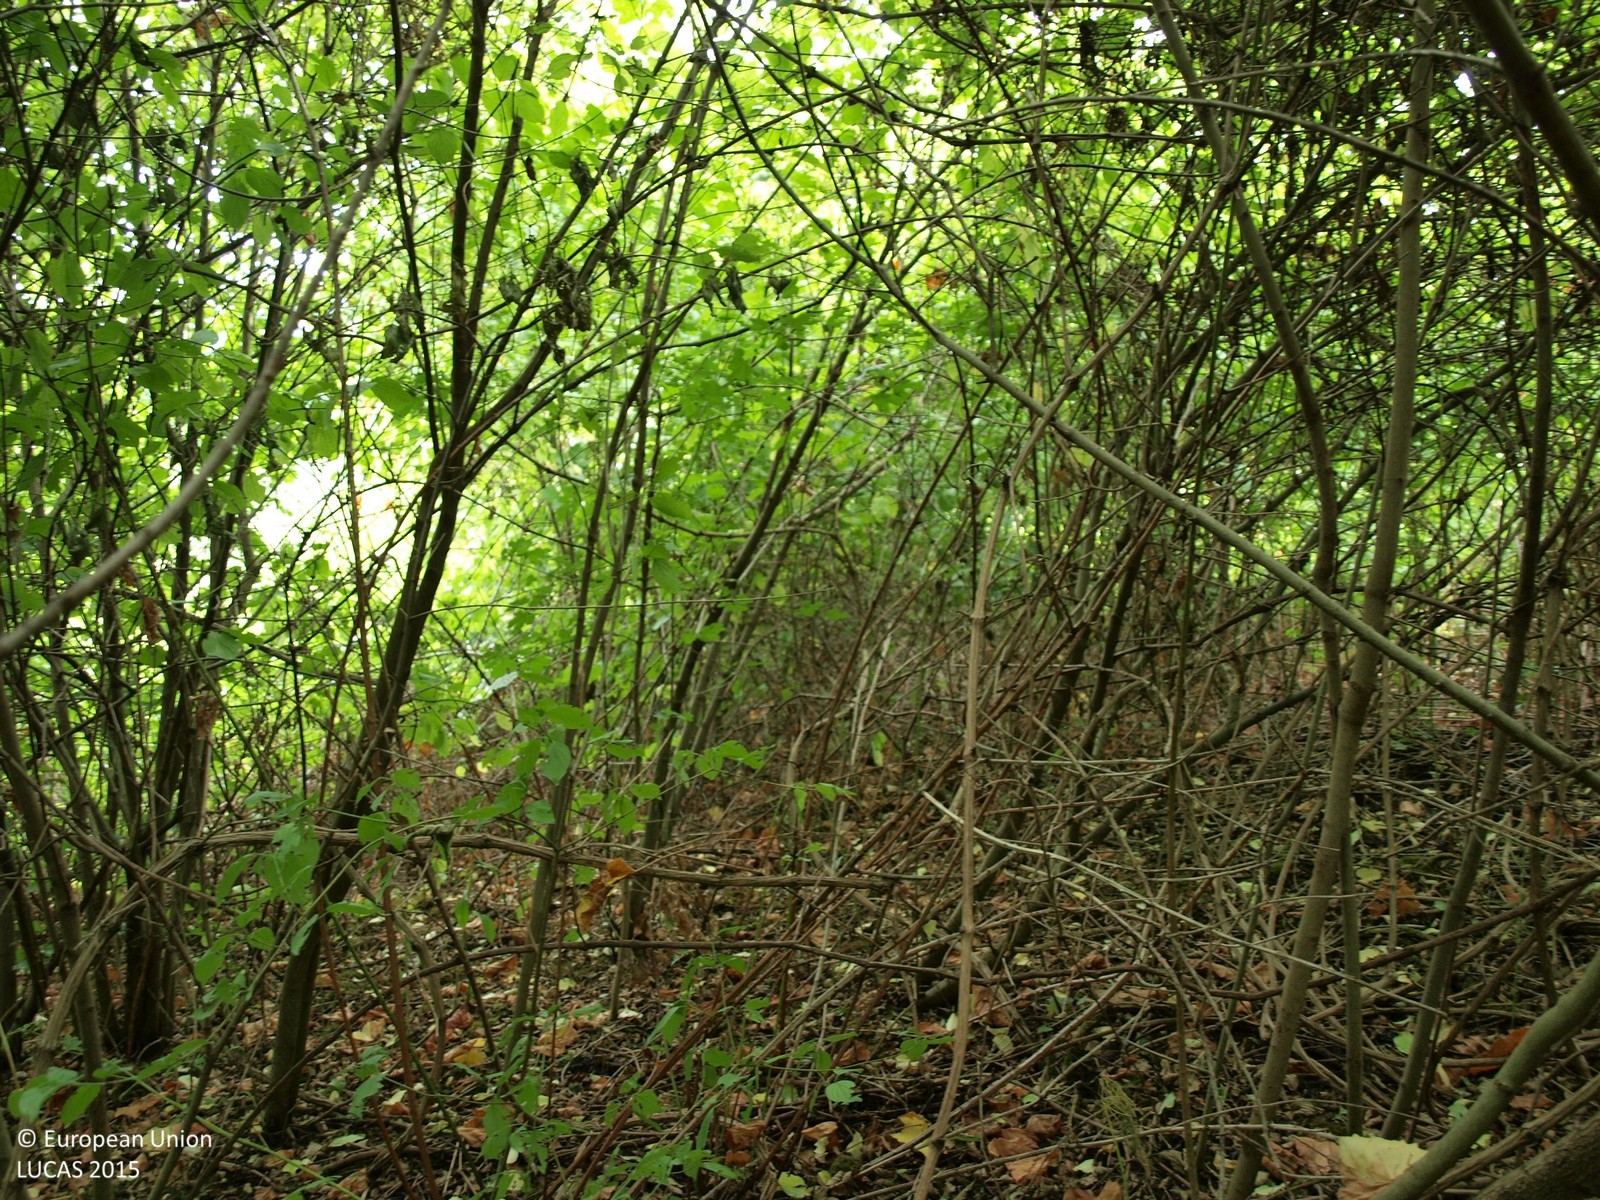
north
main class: Shrubland
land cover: Shrubland without tree cover
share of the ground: > 75 %
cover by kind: shrubs 100 %
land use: Semi-natural and natural areas not in use
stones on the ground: < 10 %
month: July
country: HR
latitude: 45.9243
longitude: 16.0977
